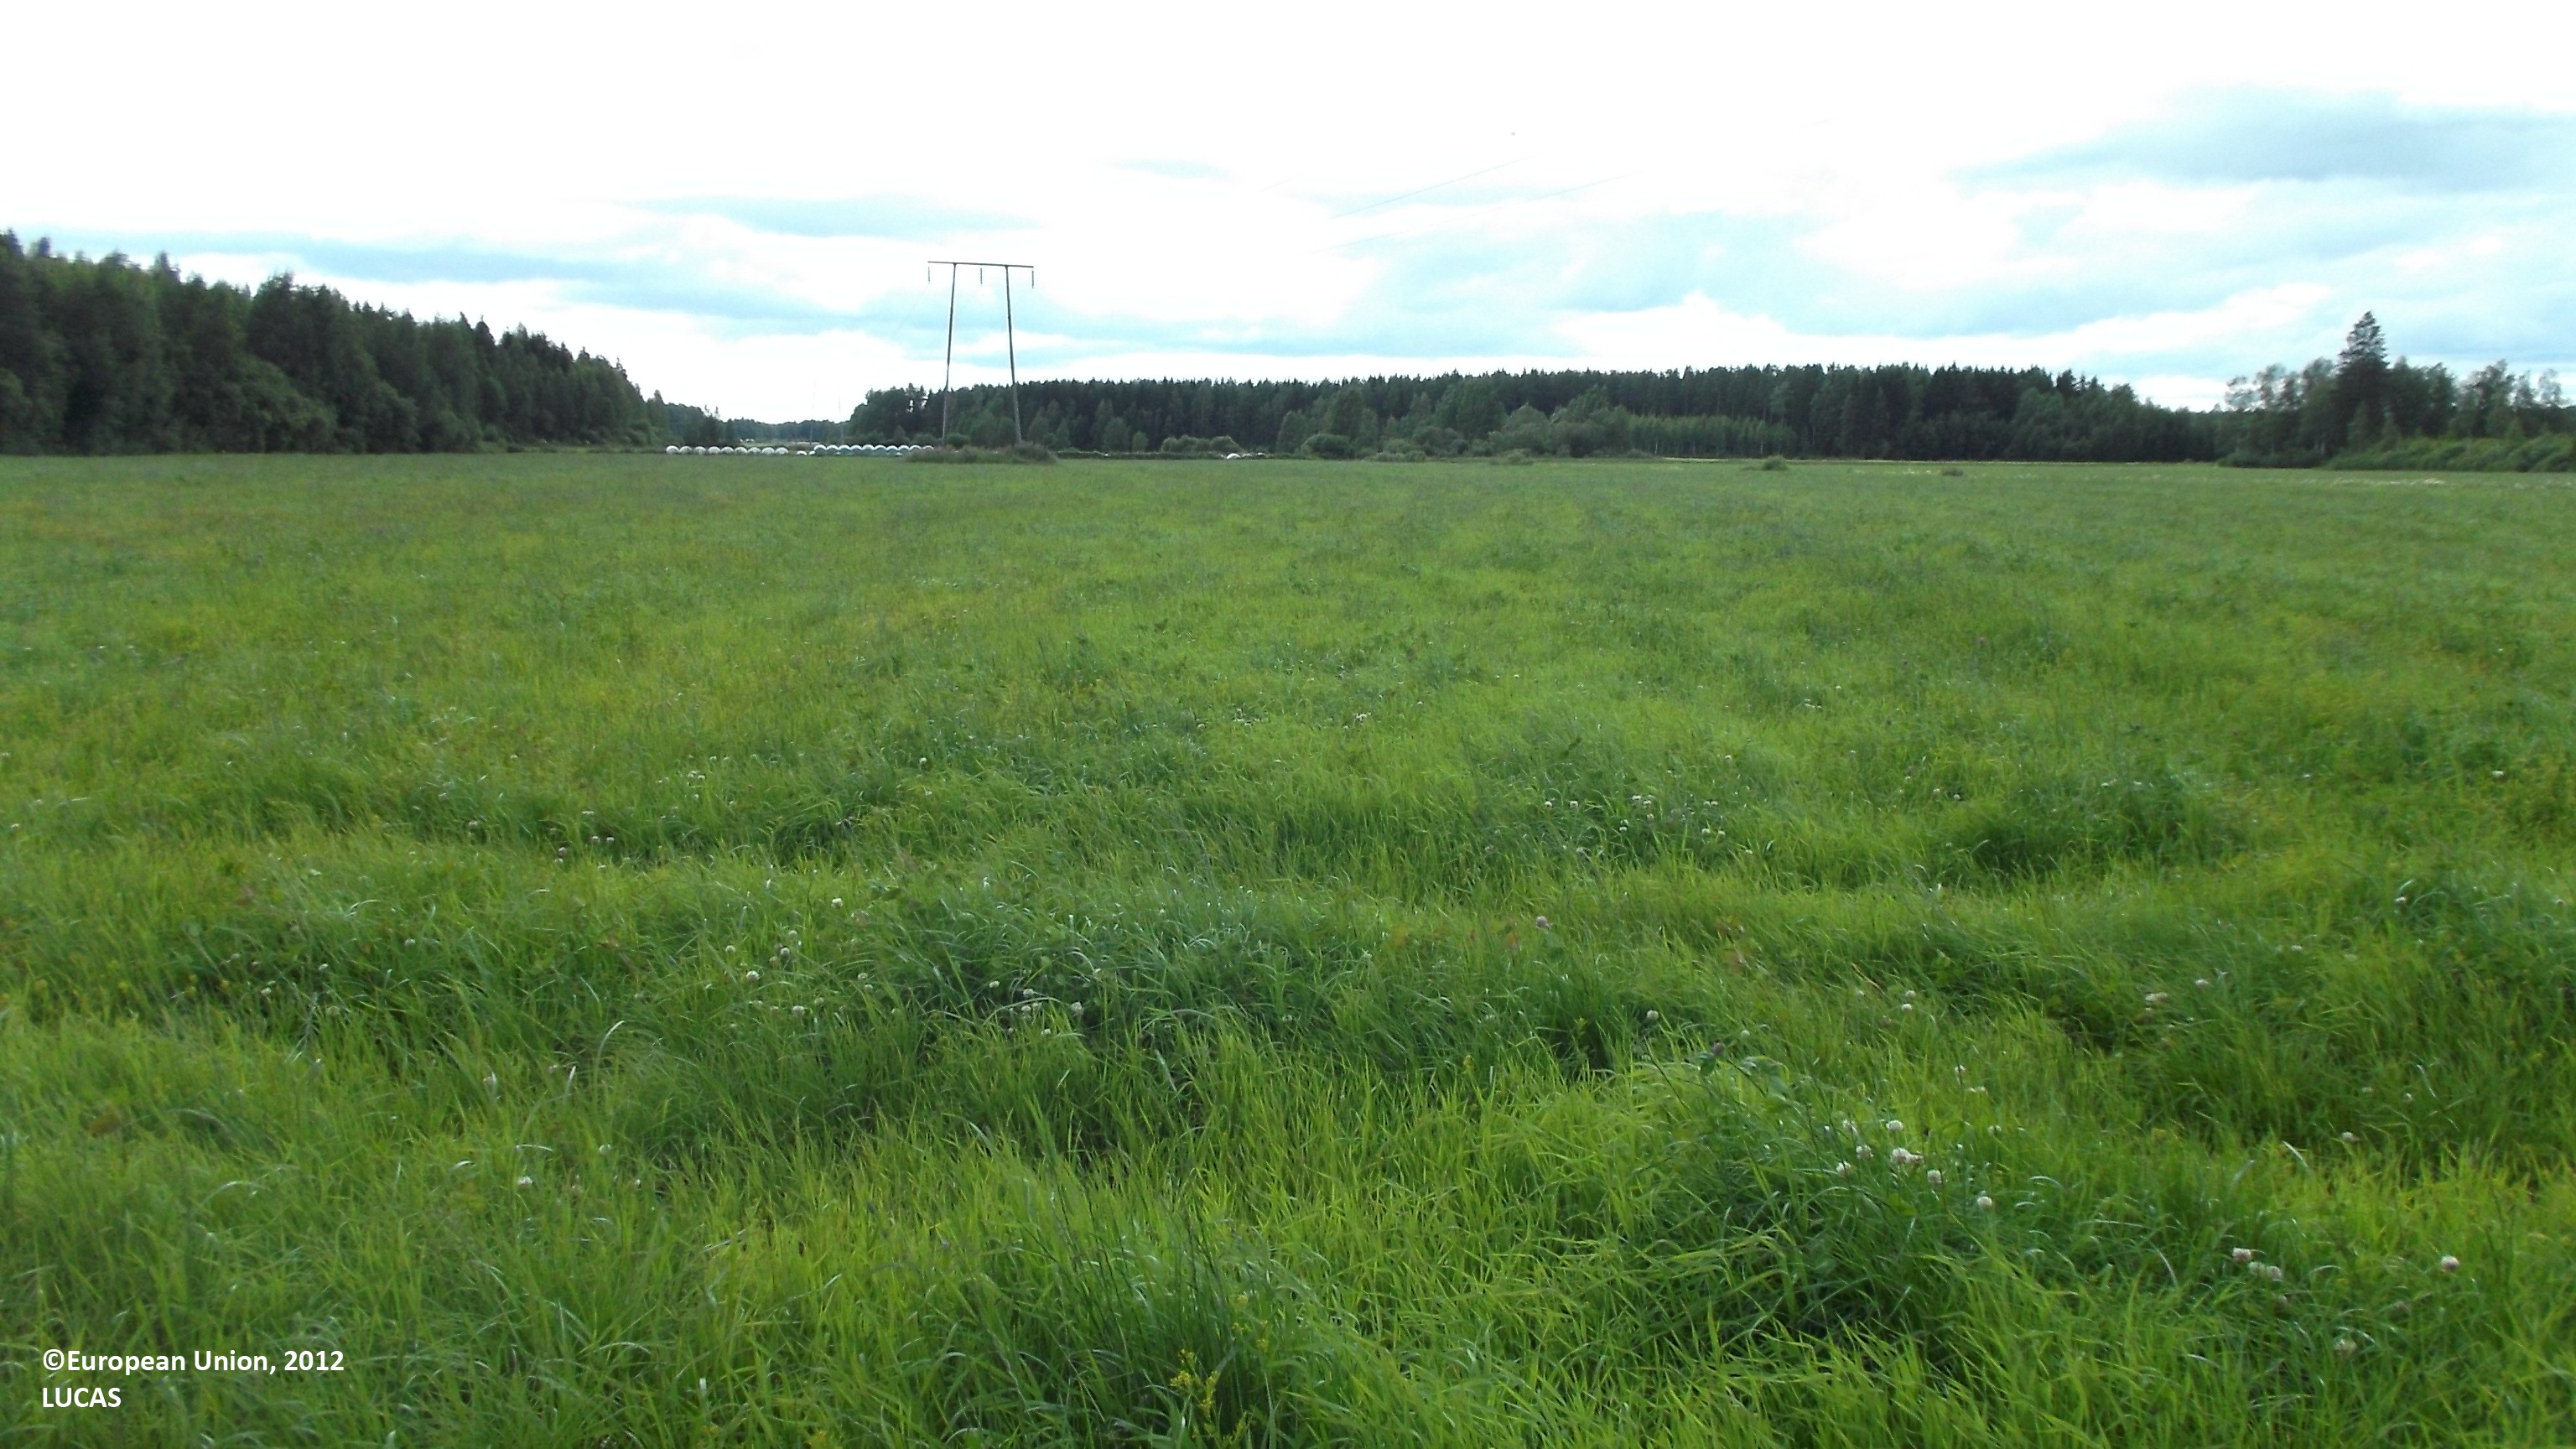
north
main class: Cropland
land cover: Temporary grasslands
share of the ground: > 75 %
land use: Agriculture (excluding fallow land and kitchen gardens)
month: July
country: FI
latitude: 63.6849
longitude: 23.3412
